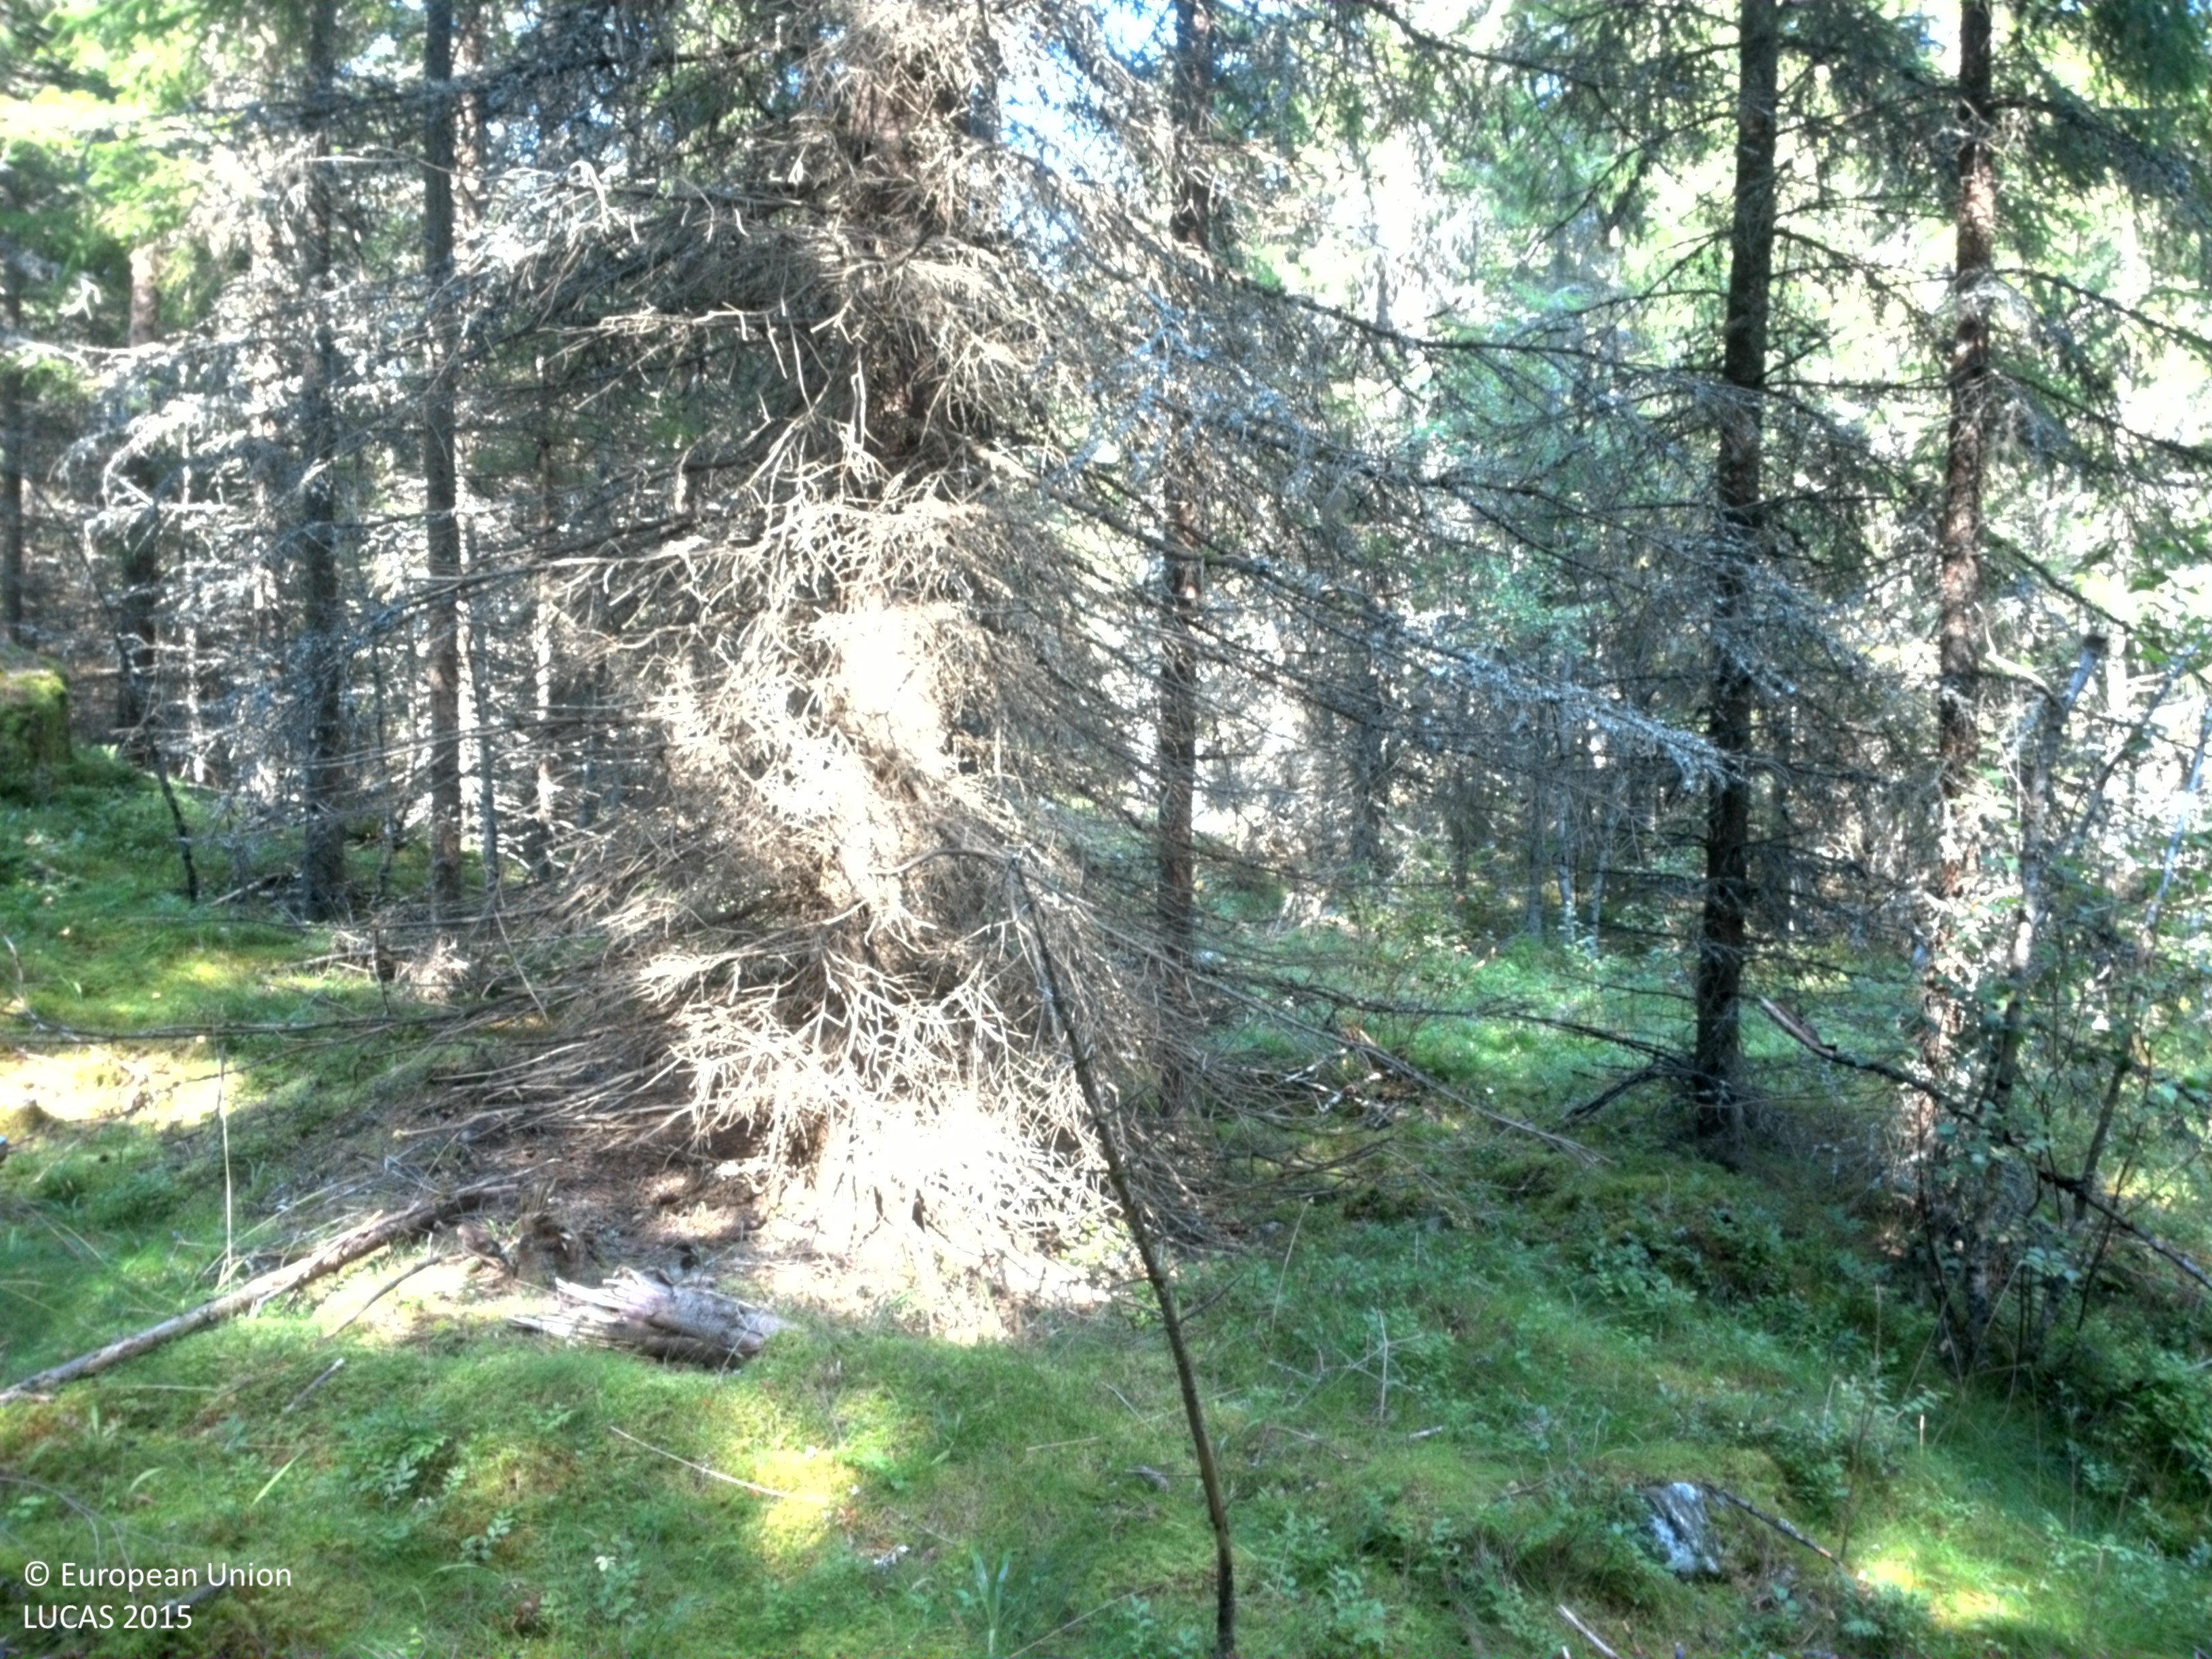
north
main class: Woodland
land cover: Spruce dominated coniferous woodland
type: boreal forest
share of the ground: > 75 %
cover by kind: coniferous forest trees 75 %, lichens and mosses 20 %, shrubs 5 %
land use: Forestry
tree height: > 5 m
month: August
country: SE
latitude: 57.9470
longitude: 13.8973
